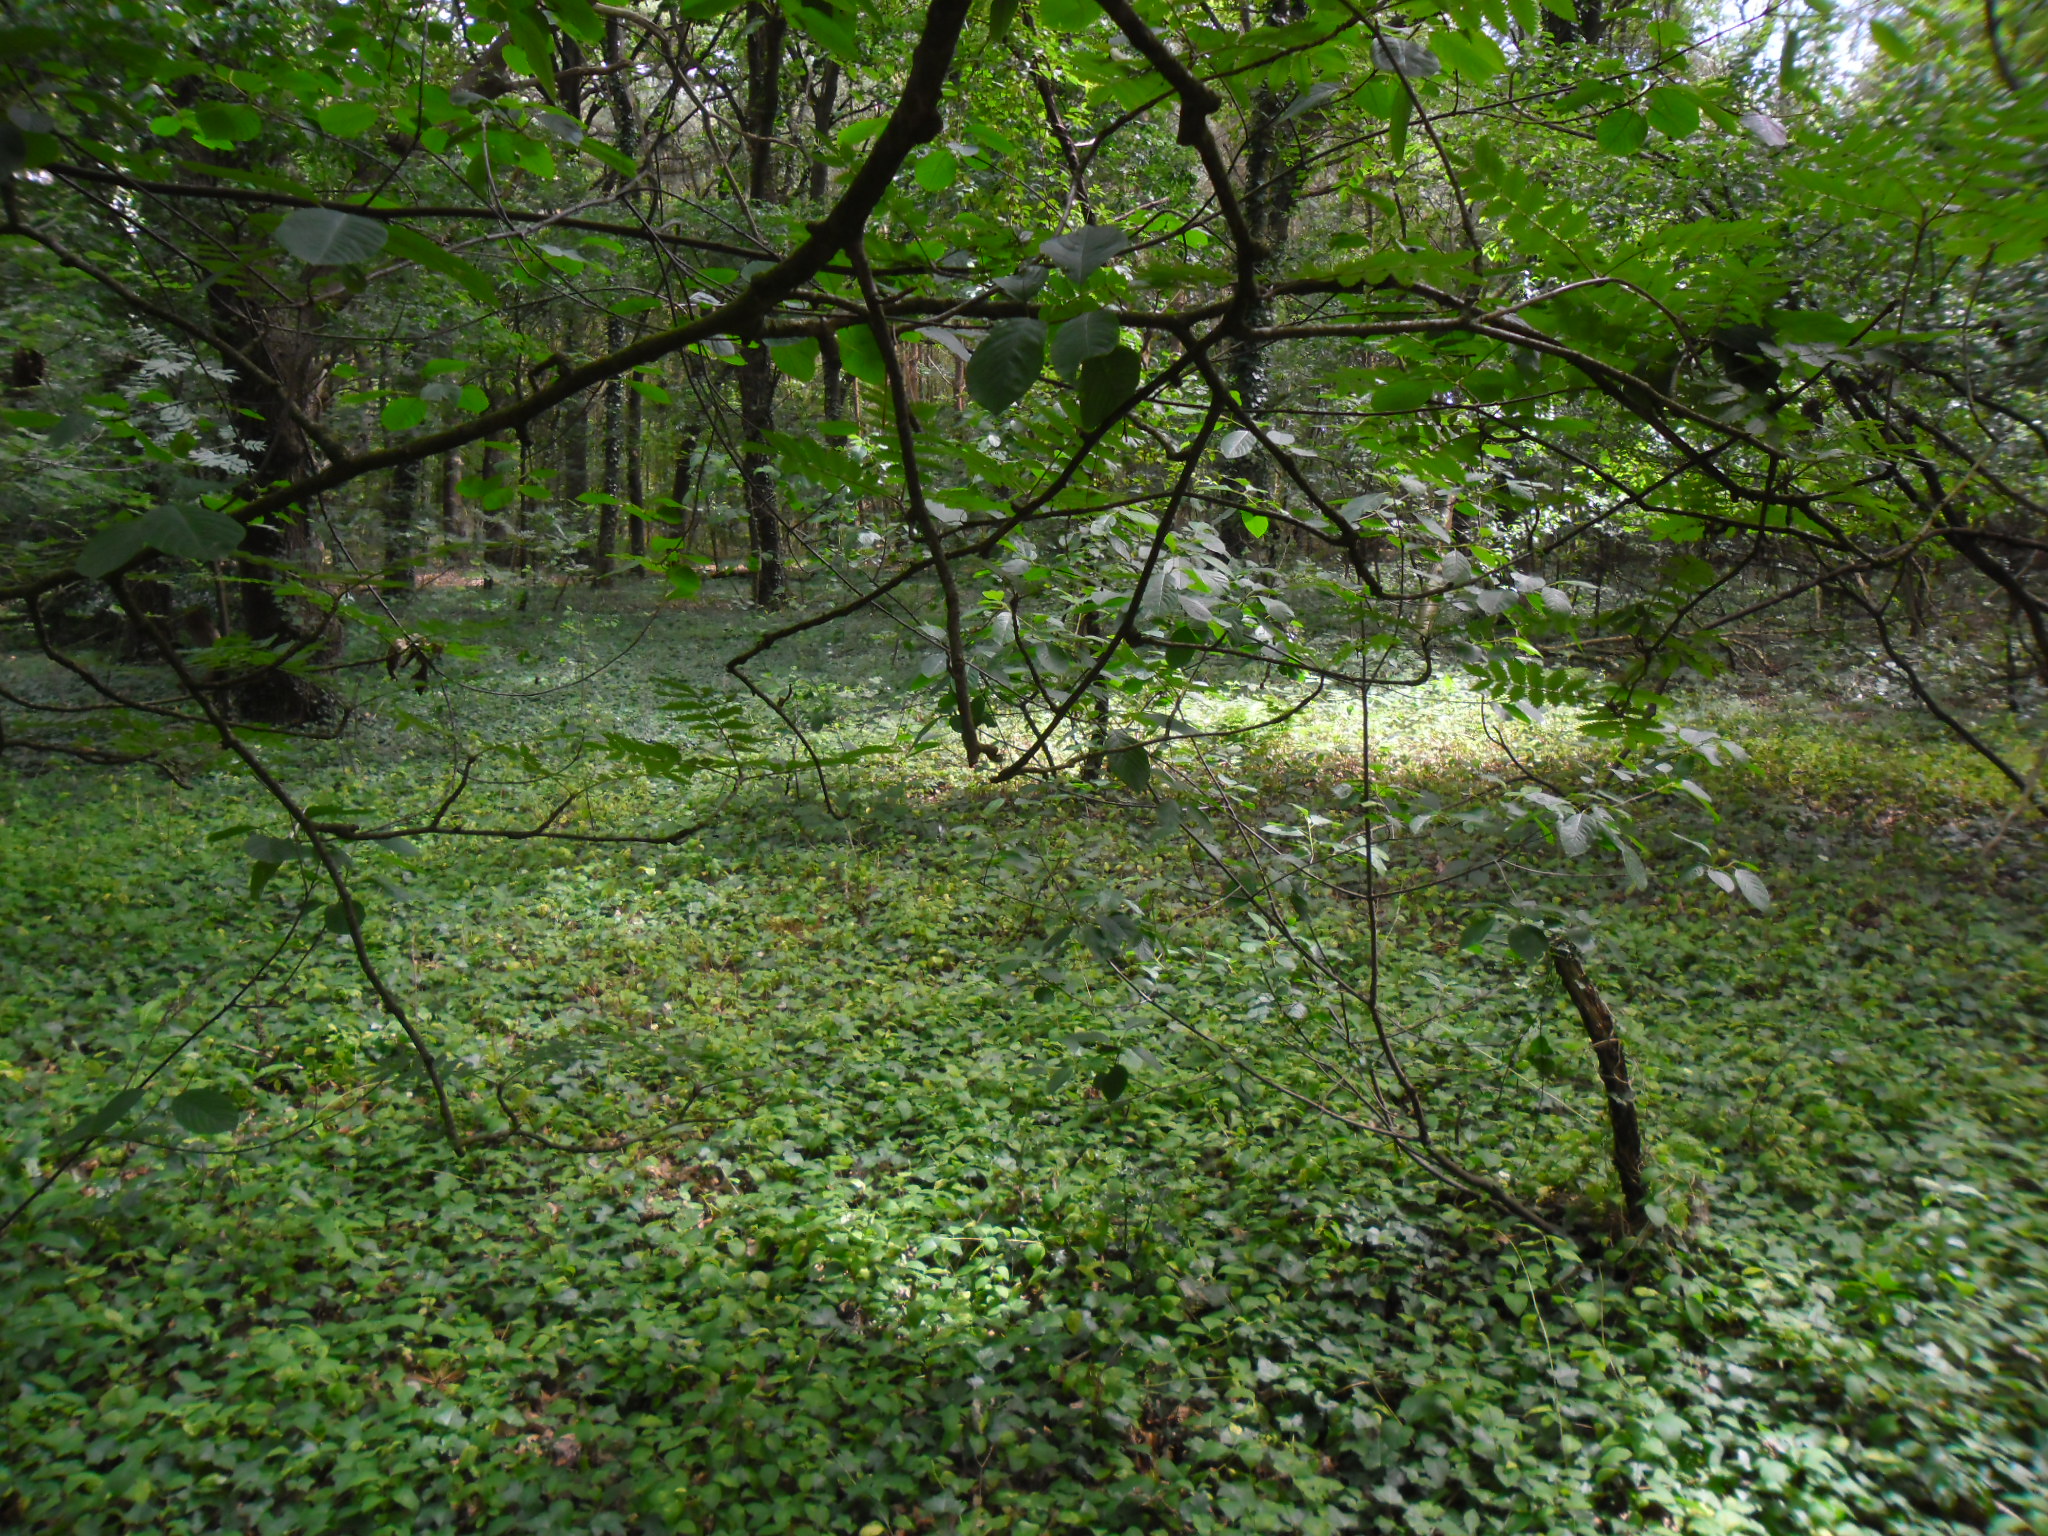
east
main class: Woodland
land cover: Broadleaved woodland
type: mesophytic deciduous forest
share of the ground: > 75 %
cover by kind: broadleaved forest trees 100 %
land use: Amenities, museums, leisure
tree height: > 5 m
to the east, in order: Broadleaved woodland; Tracks; Broadleaved woodland; Tracks; Broadleaved woodland
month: July
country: NL
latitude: 53.0513
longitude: 6.7032
